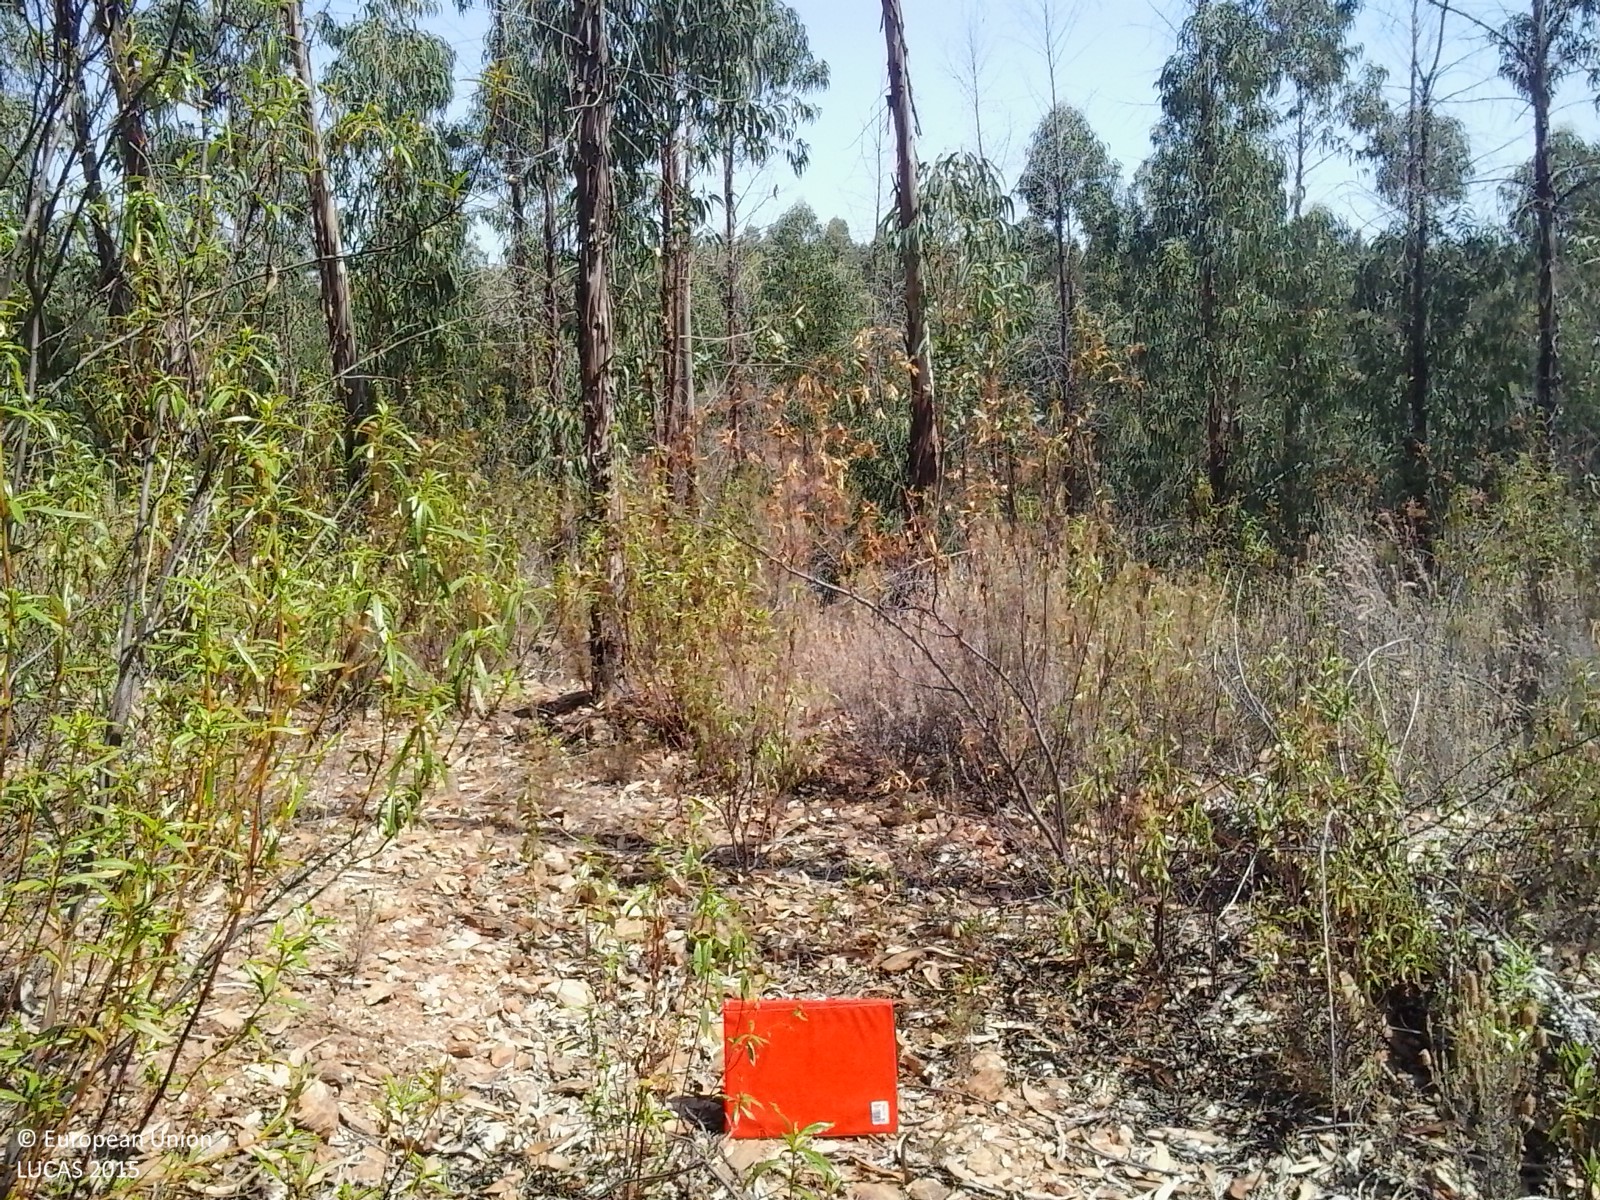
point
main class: Woodland
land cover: Broadleaved woodland
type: exotic forest
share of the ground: 25 - 50 %
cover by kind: broadleaved forest trees 45 %, shrubs 25 %, herbaceous plants 25 %, unconsolidated bare surface 5 %
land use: Forestry
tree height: > 5 m
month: July
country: ES
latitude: 37.5219
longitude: -6.4520
